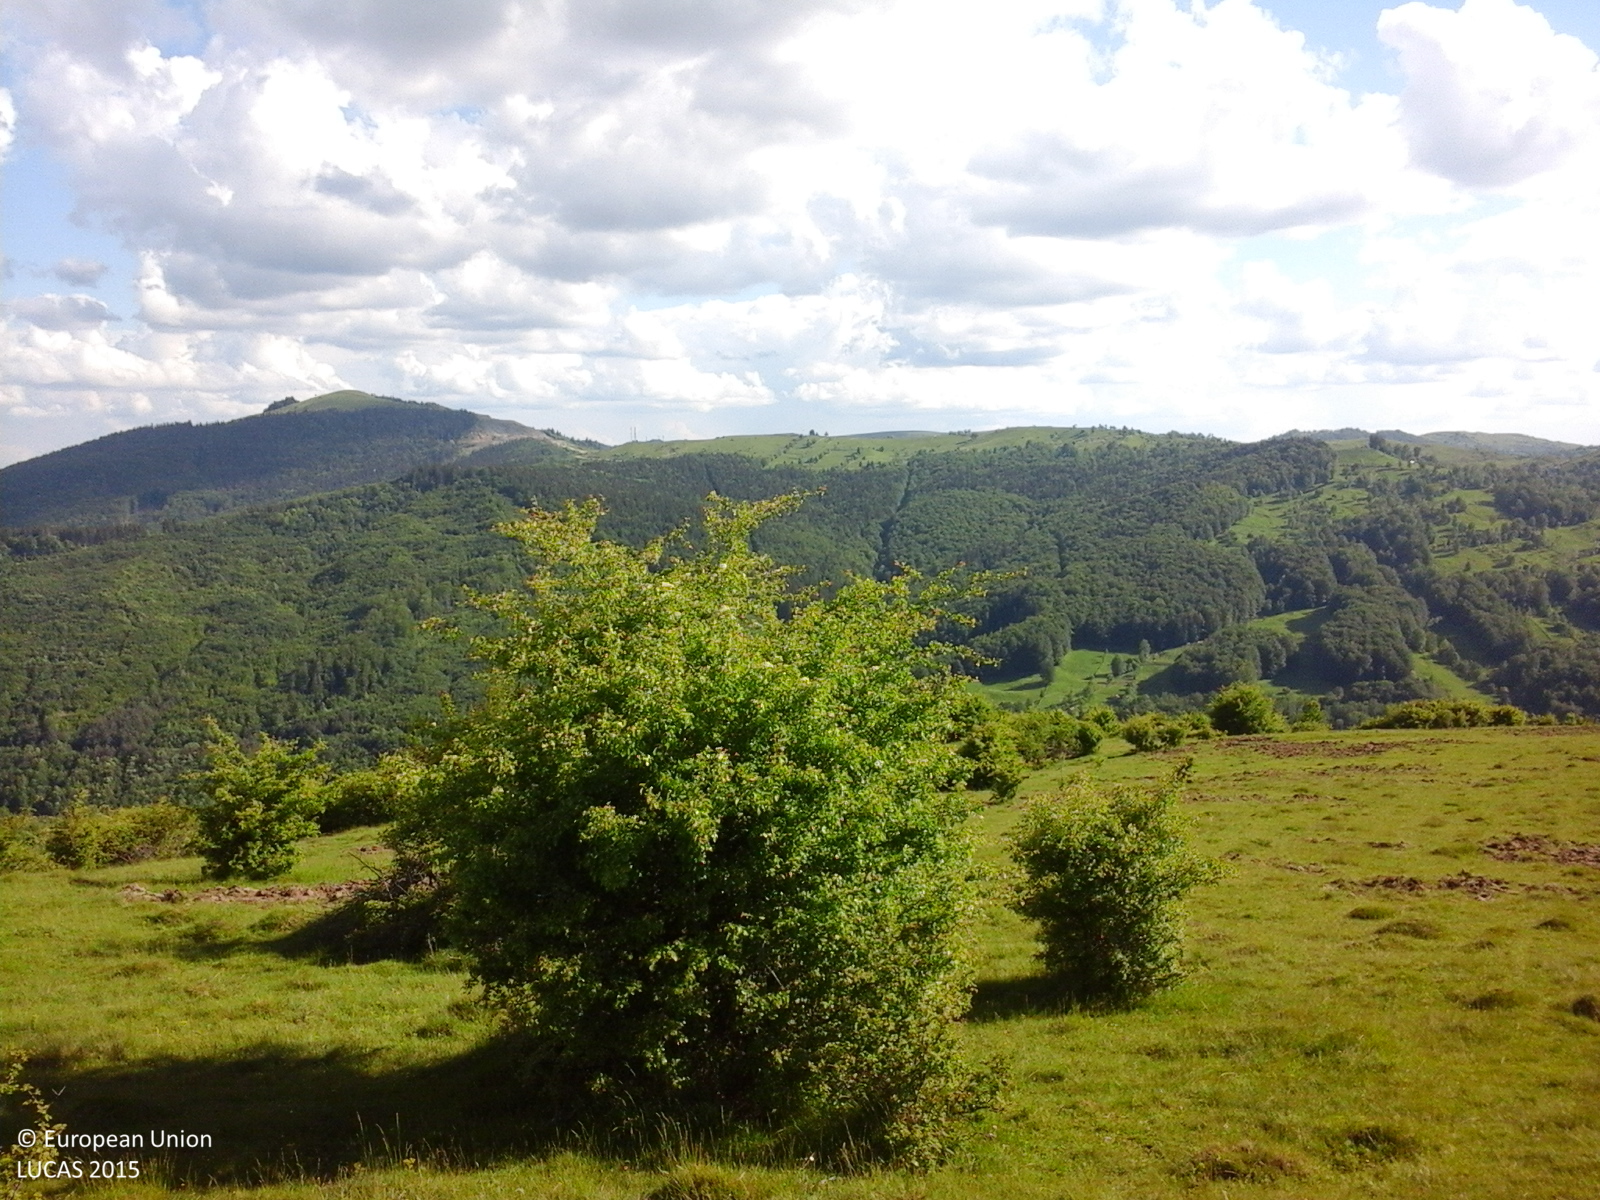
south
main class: Grassland
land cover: Grassland with sparse tree/shrub cover
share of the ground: > 75 %
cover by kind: herbaceous plants 85 %, shrubs 10 %, broadleaved forest trees 5 %
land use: Agriculture (excluding fallow land and kitchen gardens)
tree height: < 5 m
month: May
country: RO
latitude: 45.3105
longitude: 25.7033
